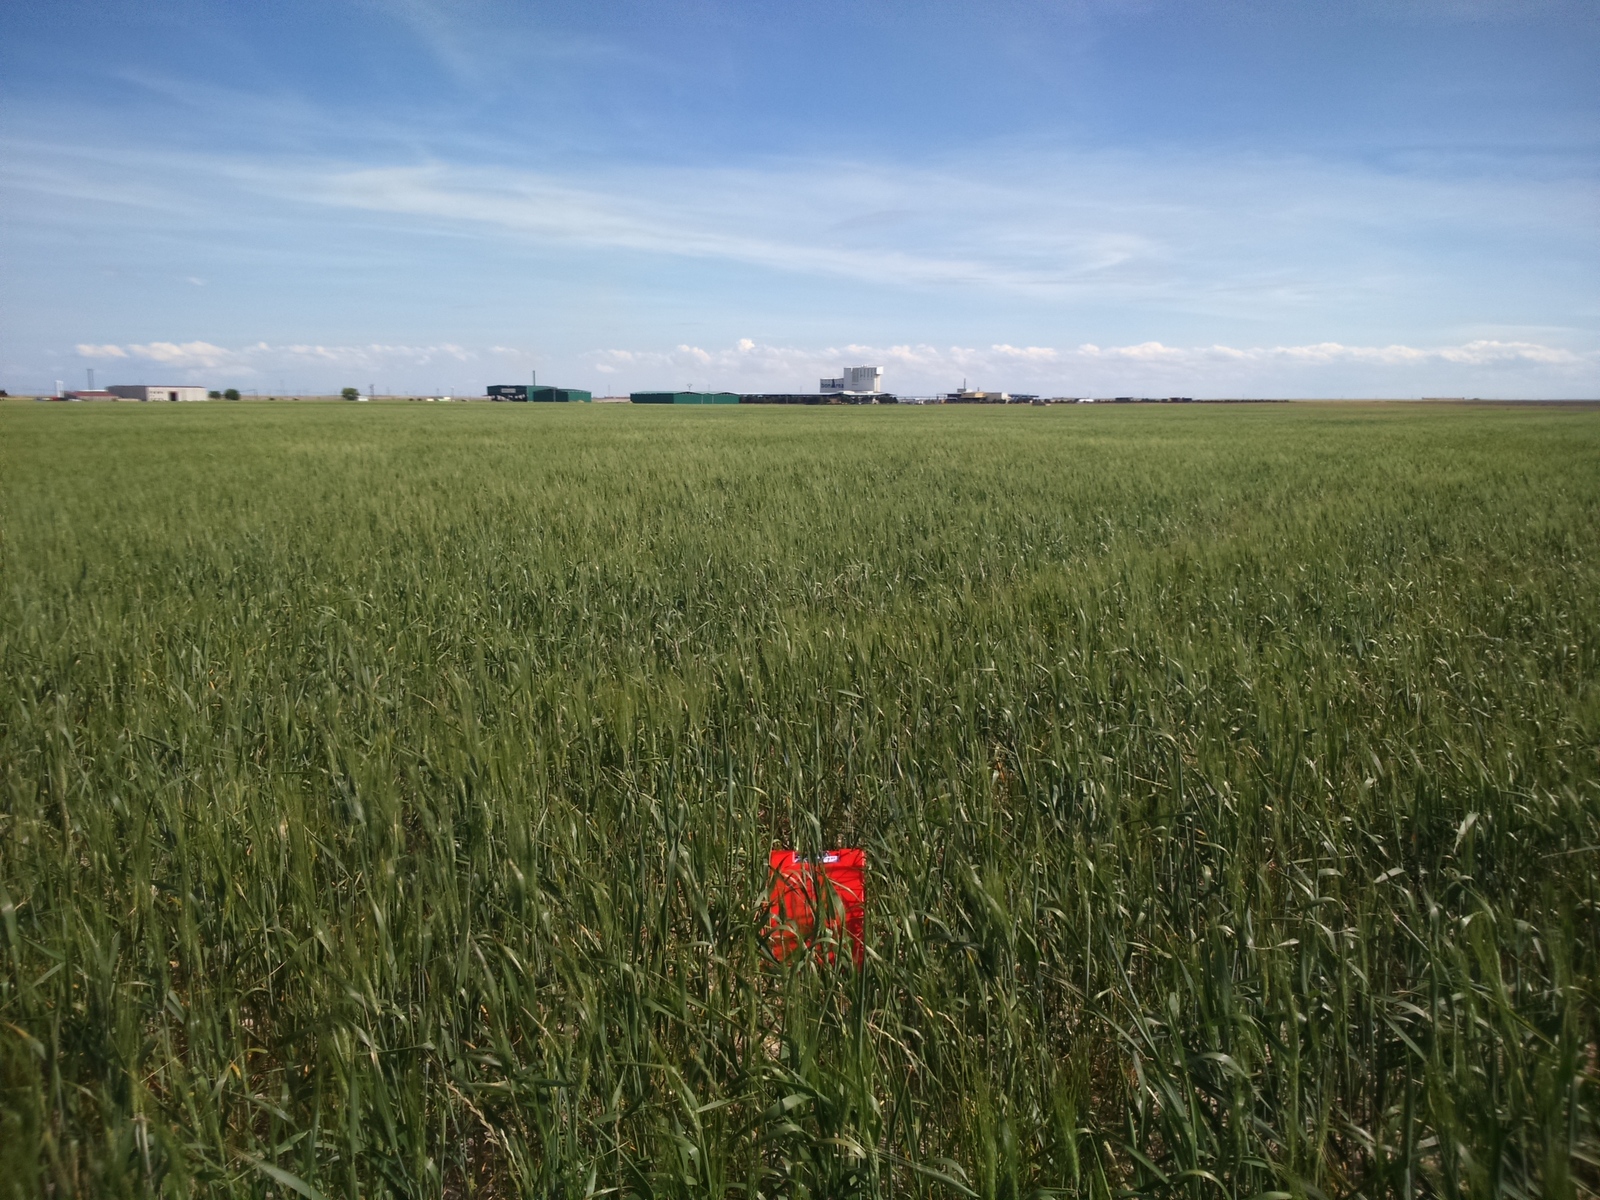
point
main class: Cropland
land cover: Barley
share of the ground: > 75 %
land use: Agriculture (excluding fallow land and kitchen gardens)
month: April
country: ES
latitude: 41.4869
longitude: -0.1600
